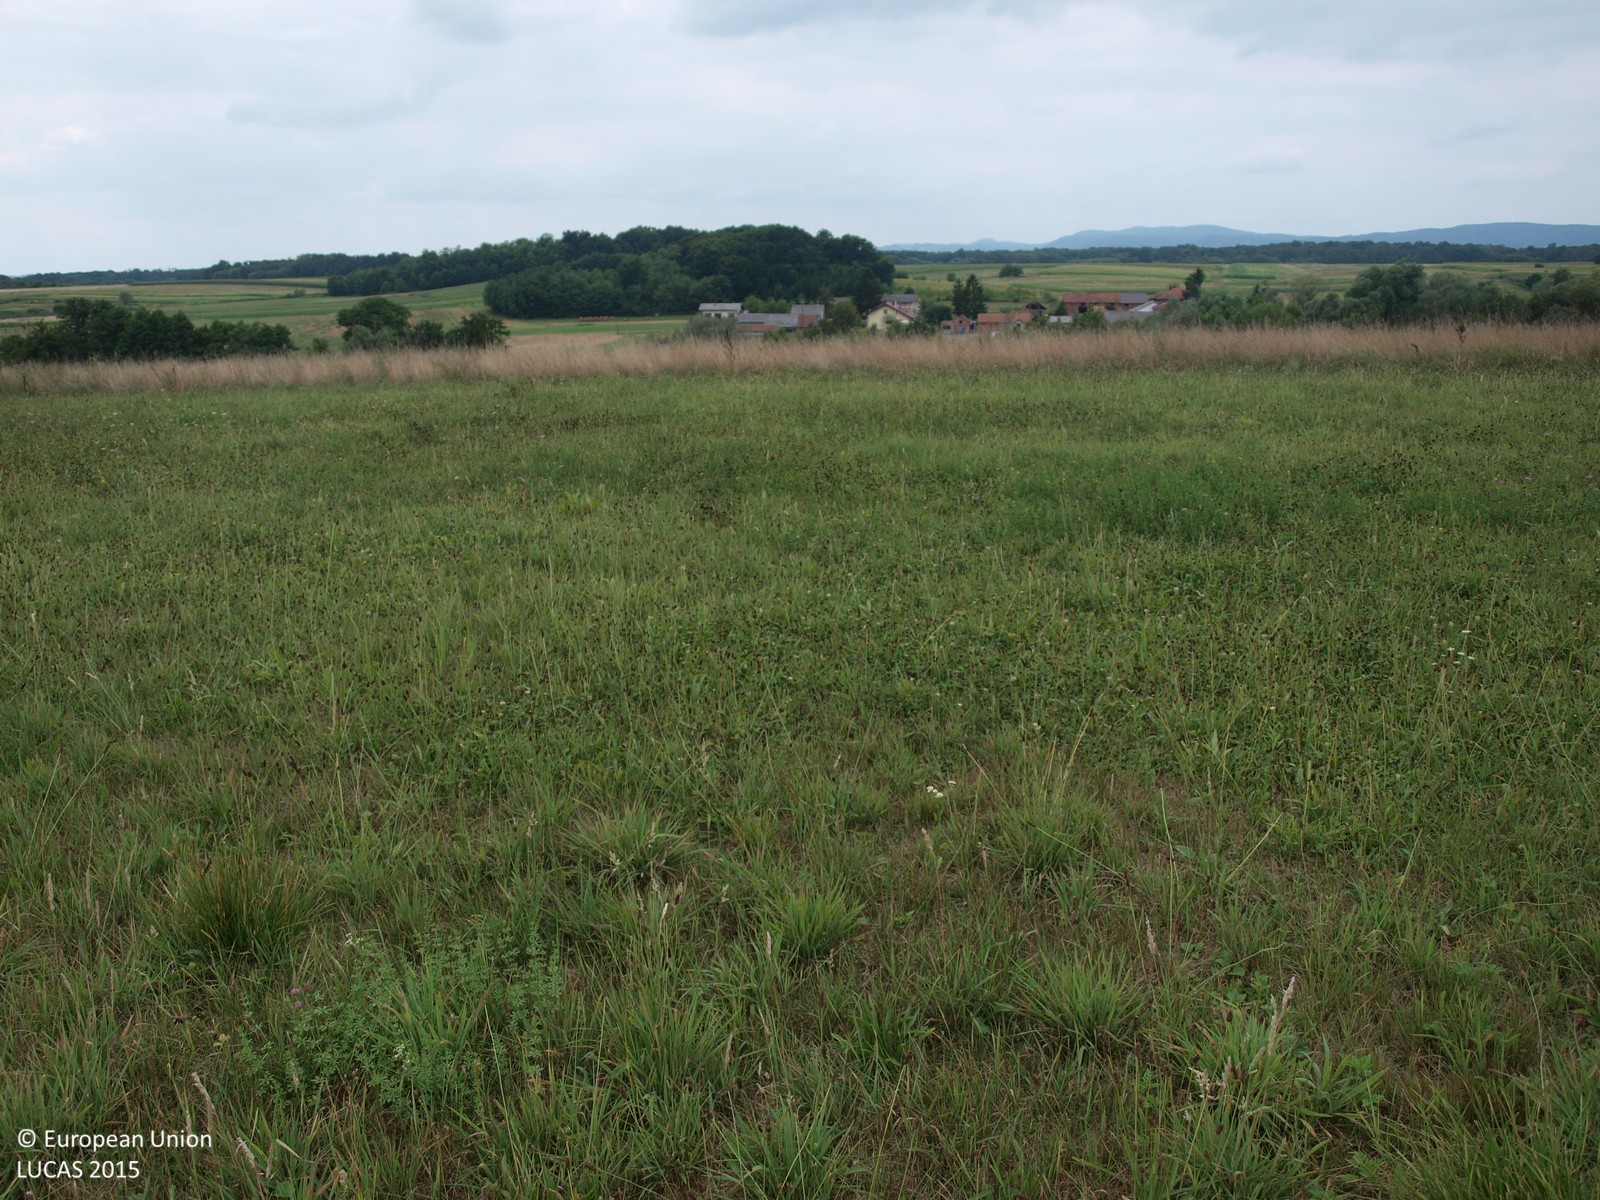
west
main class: Grassland
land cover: Grassland without tree/shrub cover
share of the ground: > 75 %
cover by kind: herbaceous plants 100 %
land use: Agriculture (excluding fallow land and kitchen gardens)
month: August
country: HR
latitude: 45.9467
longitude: 16.3330
